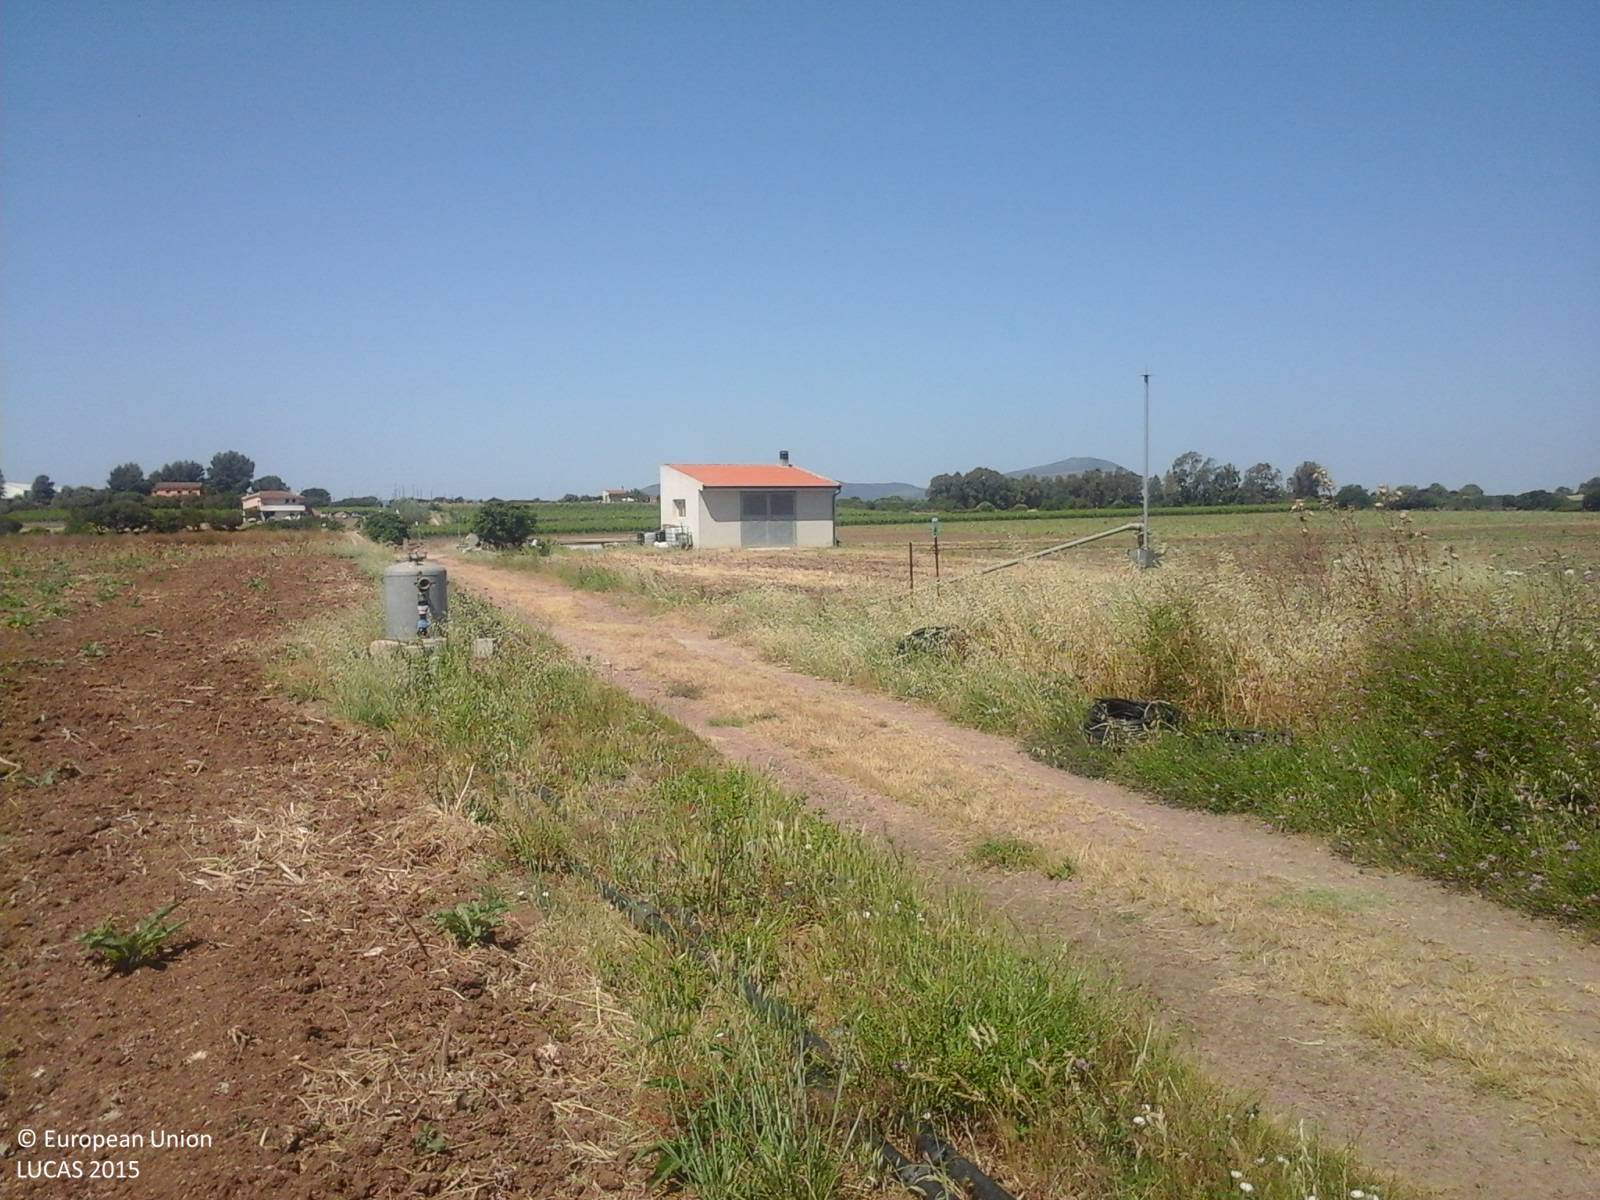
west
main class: Cropland
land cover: Other fresh vegetables
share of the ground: < 10 %
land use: Agriculture (excluding fallow land and kitchen gardens)
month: June
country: IT
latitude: 40.6161
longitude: 8.3885
